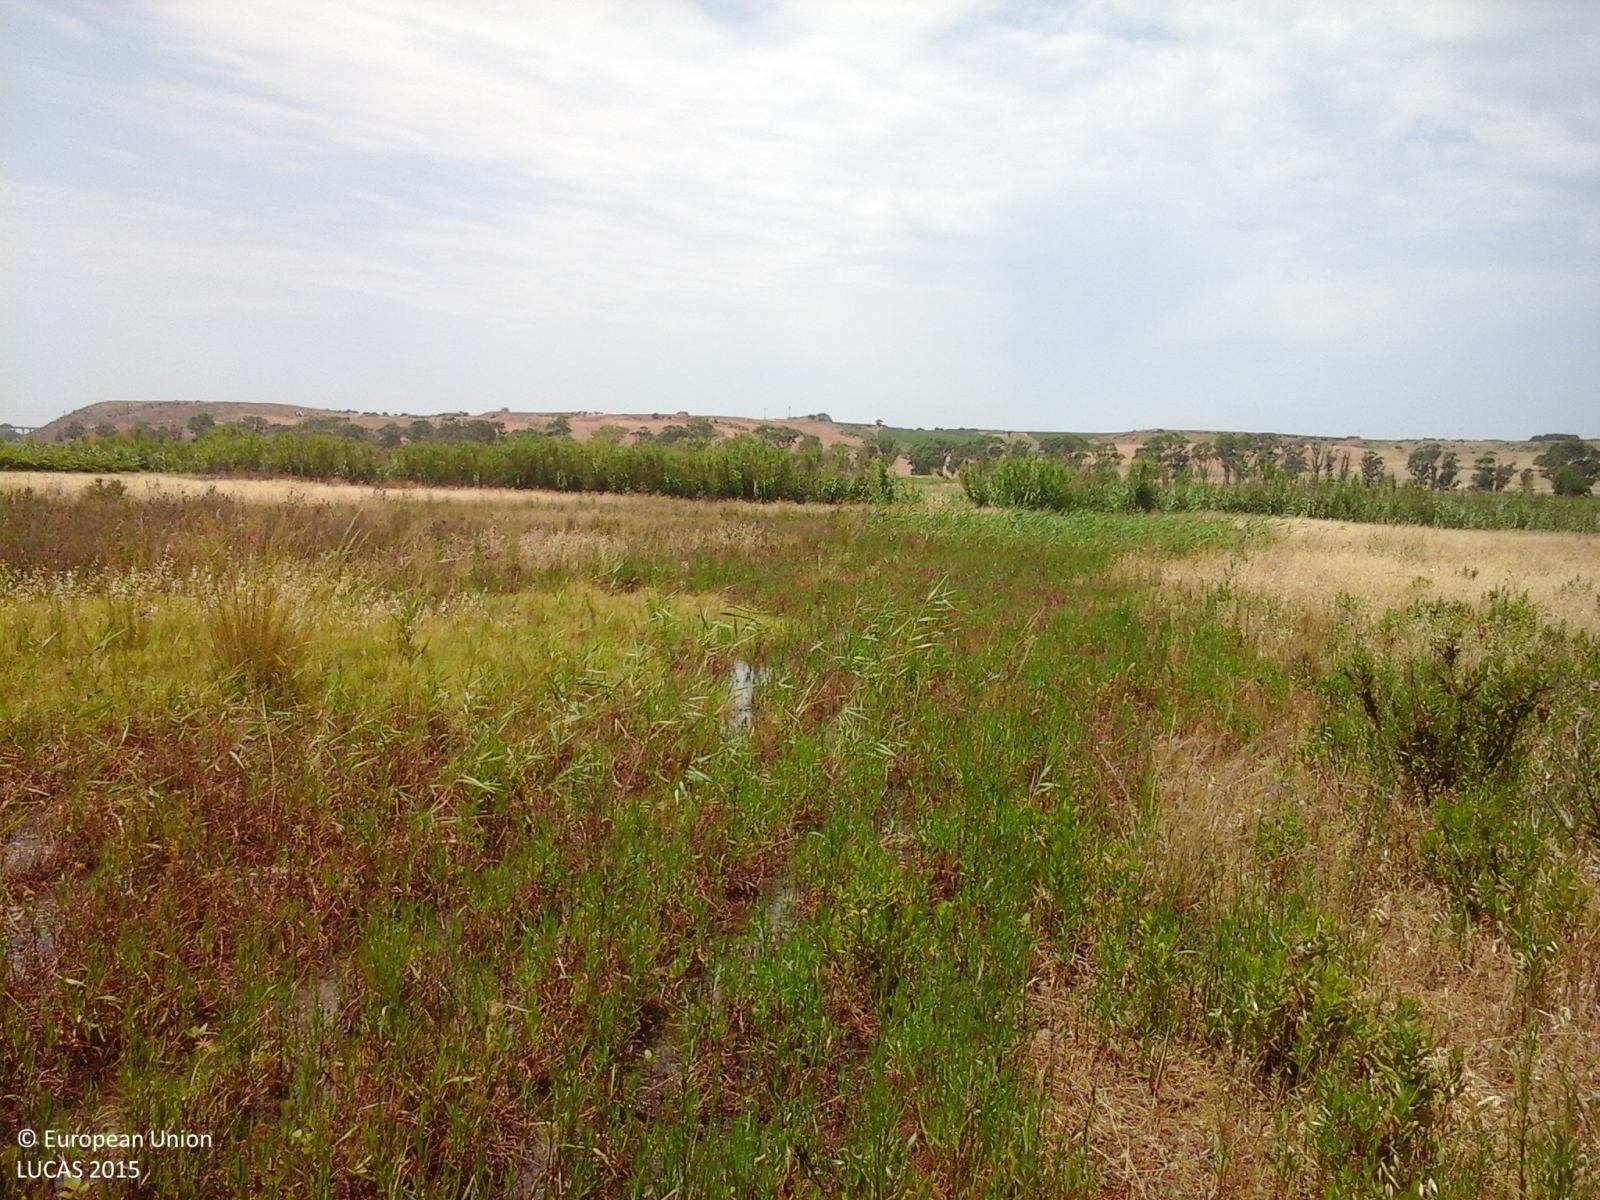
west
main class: Grassland
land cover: Spontaneously vegetated surfaces
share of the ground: > 75 %
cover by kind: herbaceous plants 100 %
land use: Fallow land
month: May
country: IT
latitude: 37.6557
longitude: 12.6661
